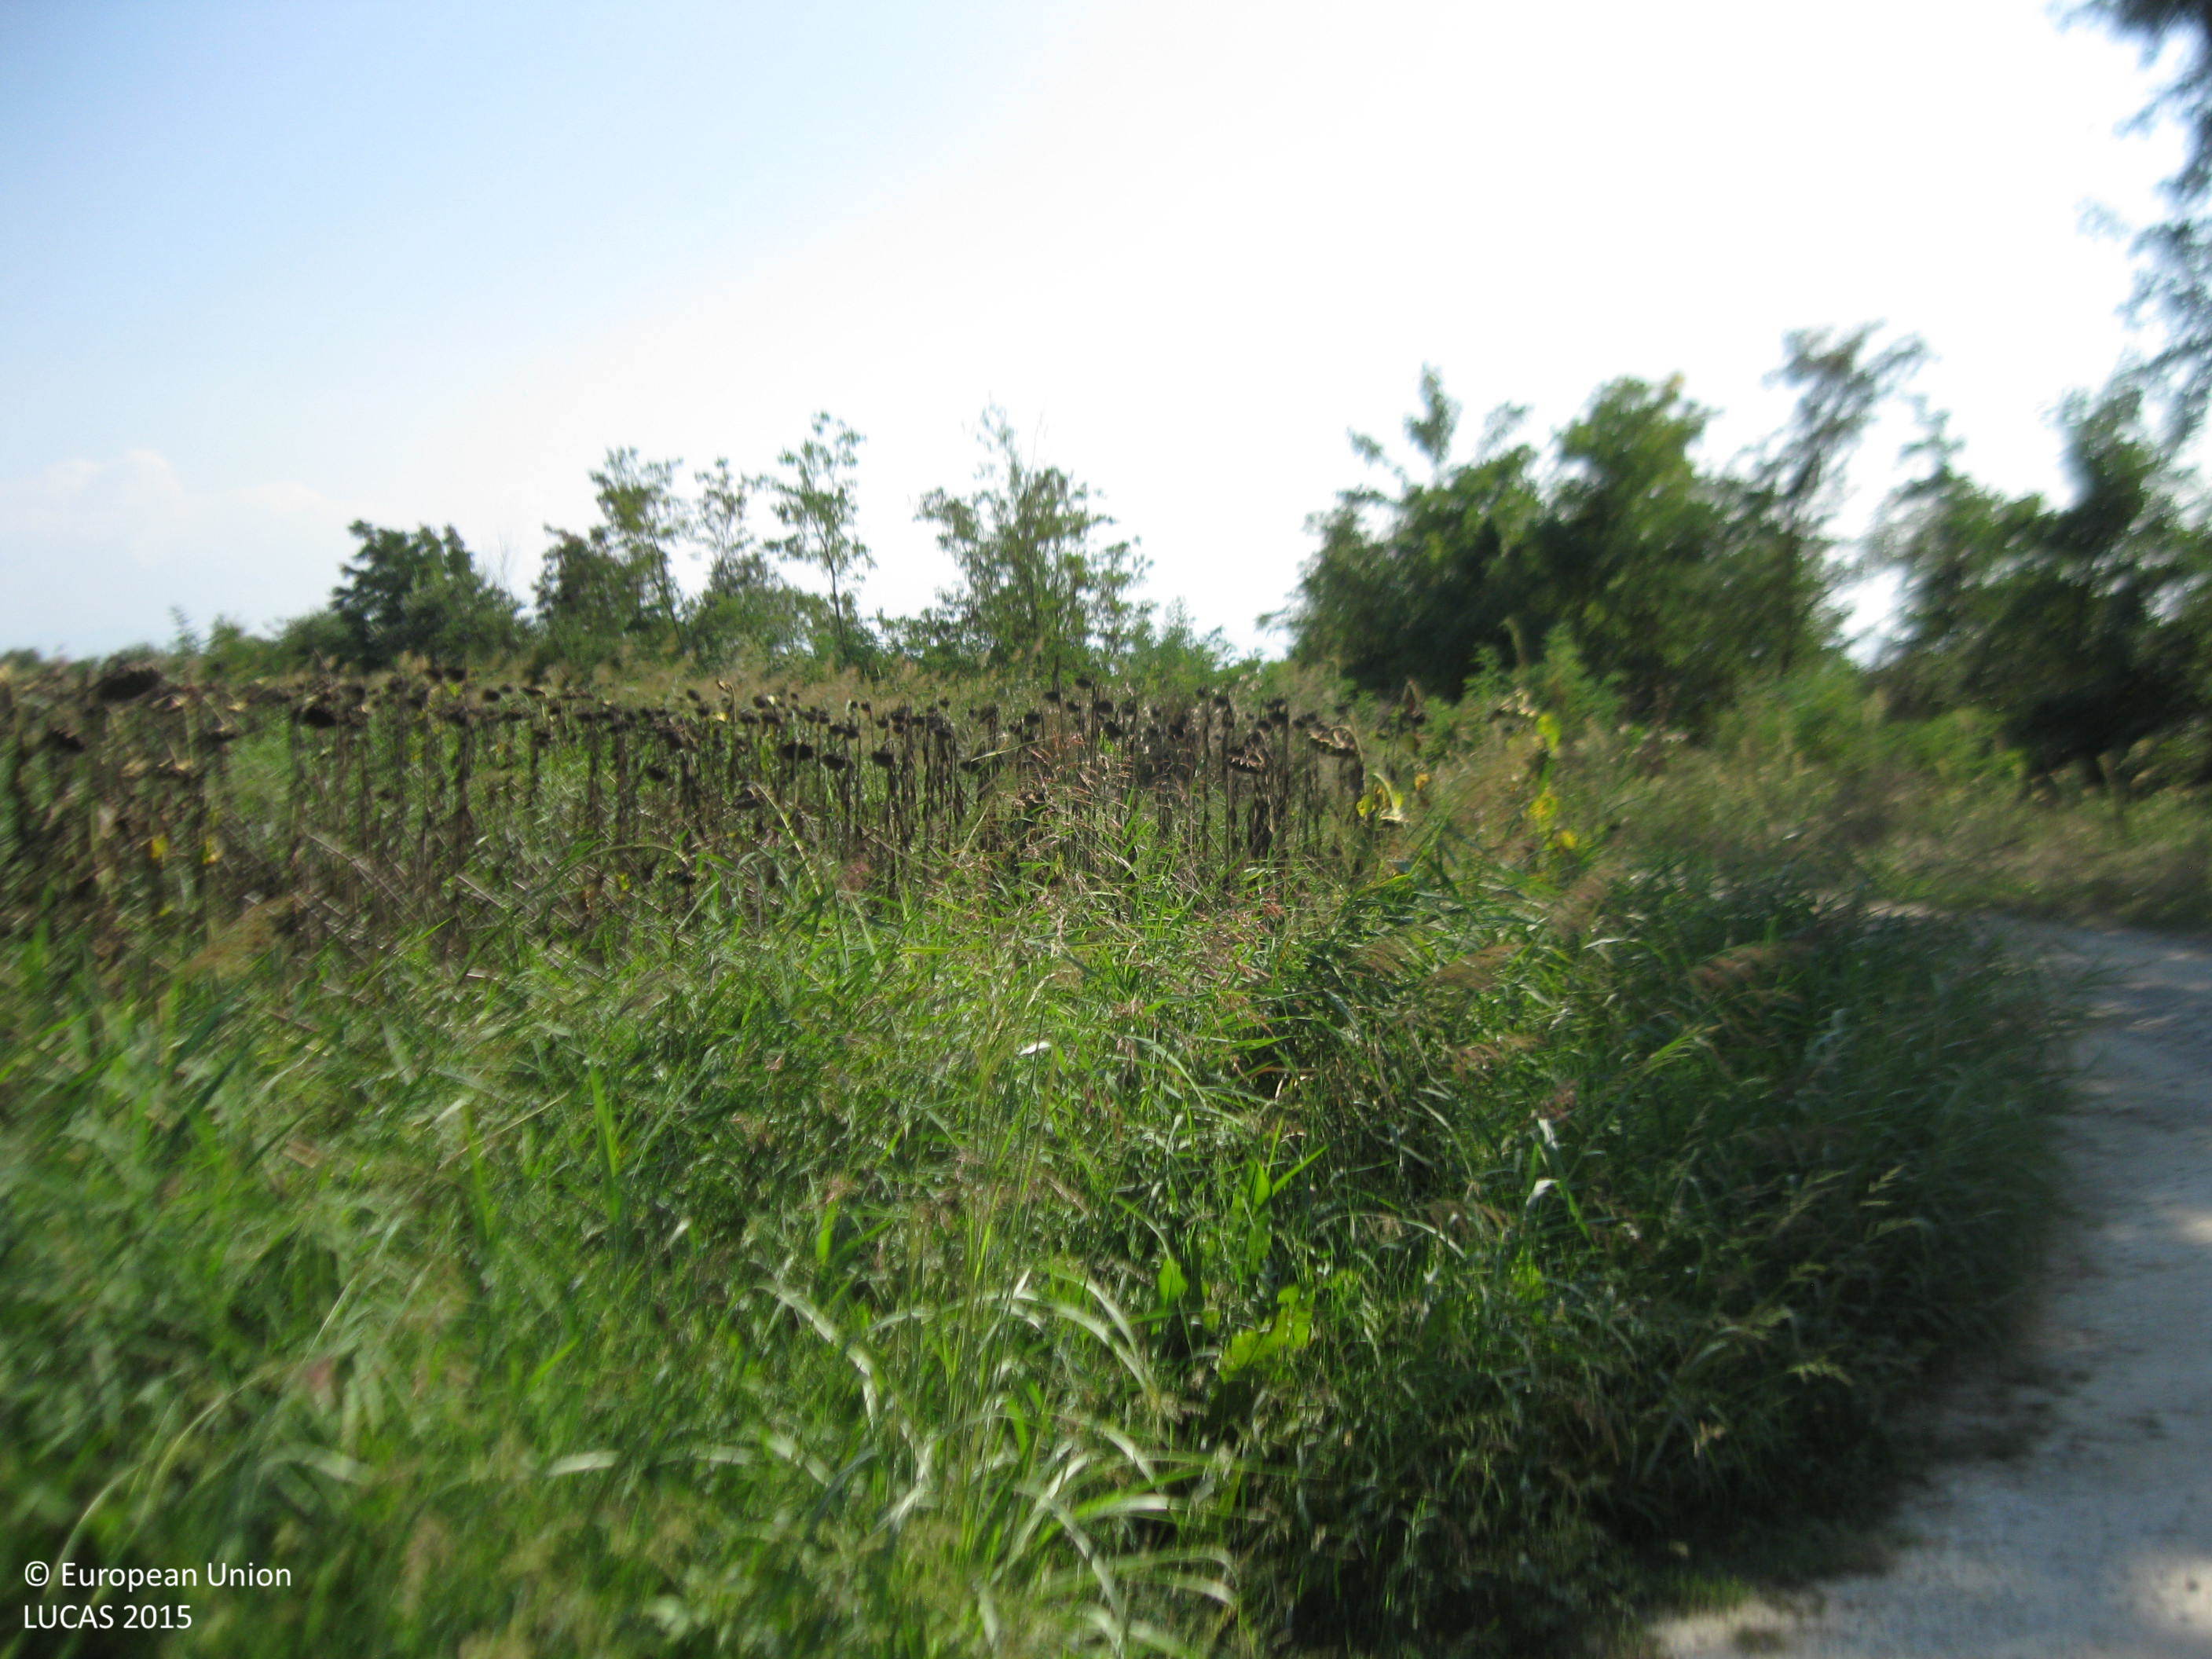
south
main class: Cropland
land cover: Apple fruit
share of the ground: 50 - 75 %
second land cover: Spontaneously vegetated surfaces
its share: > 75 %
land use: Agriculture (excluding fallow land and kitchen gardens)
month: September
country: BG
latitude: 42.2520
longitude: 24.8293
